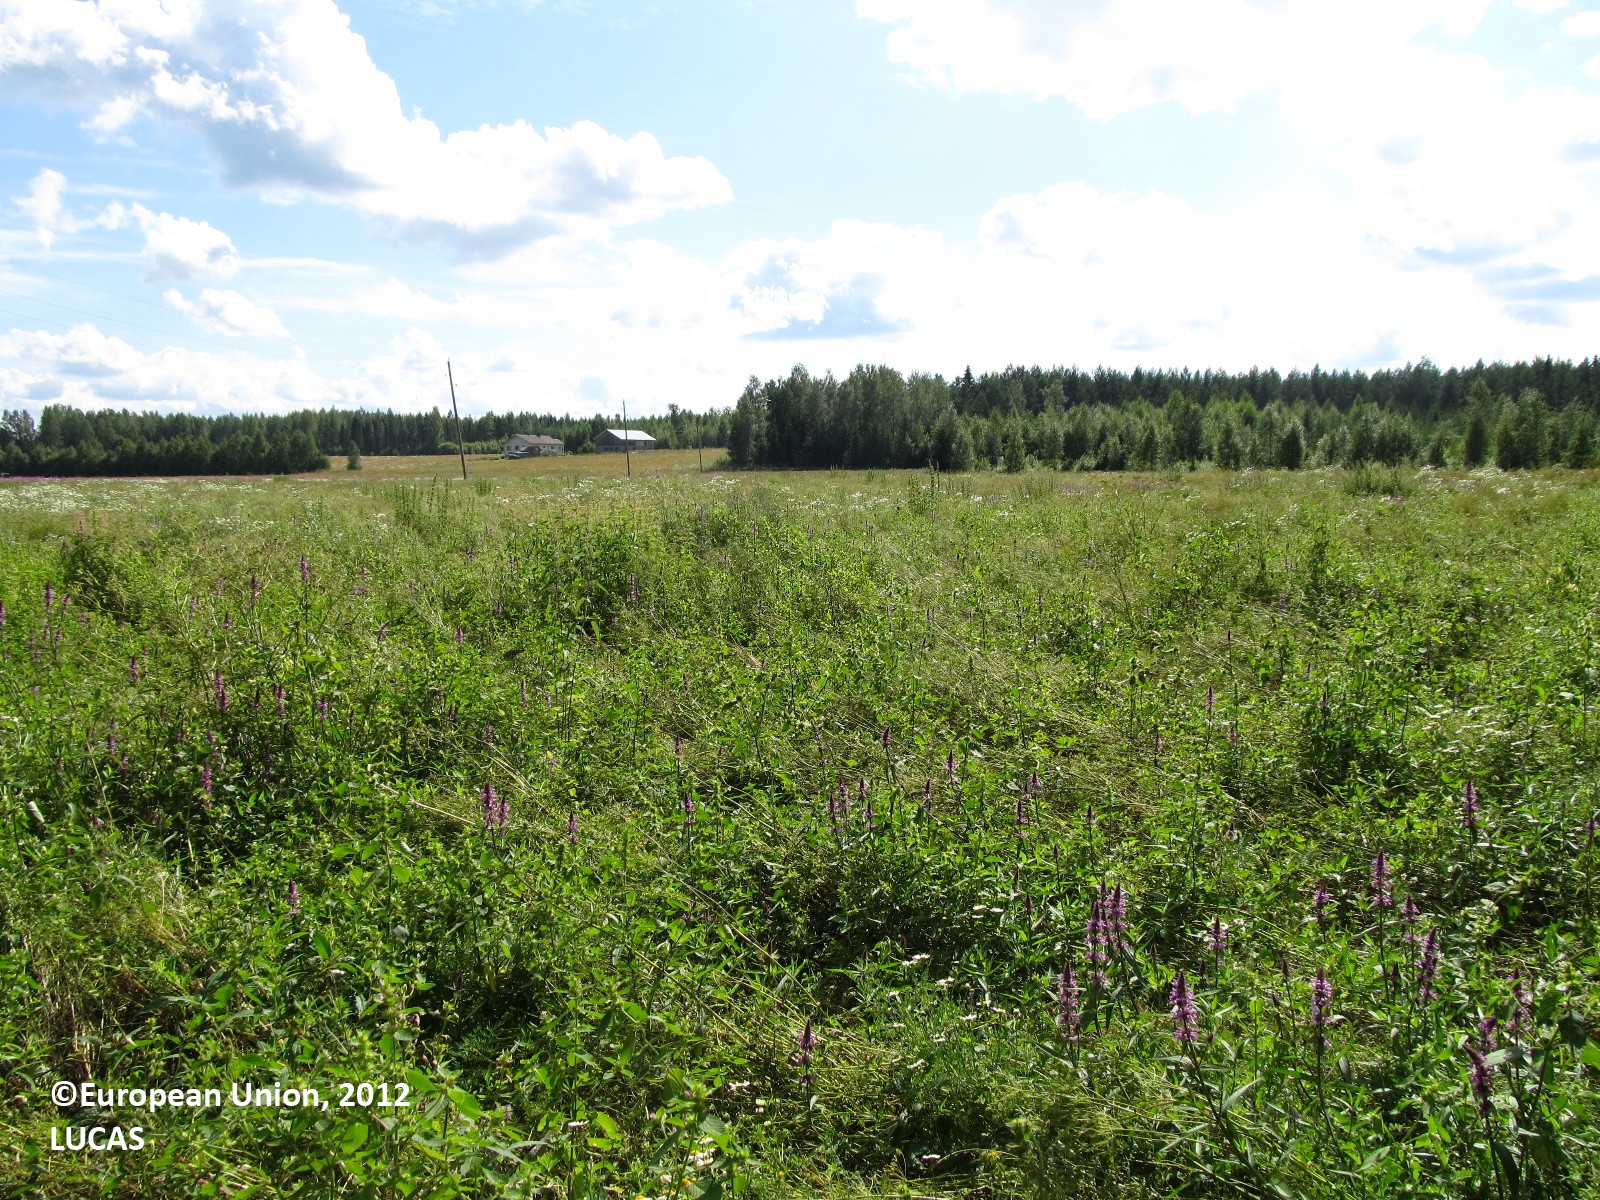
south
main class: Grassland
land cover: Grassland without tree/shrub cover
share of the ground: > 75 %
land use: Fallow land
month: July
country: FI
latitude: 61.9300
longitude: 28.0806
